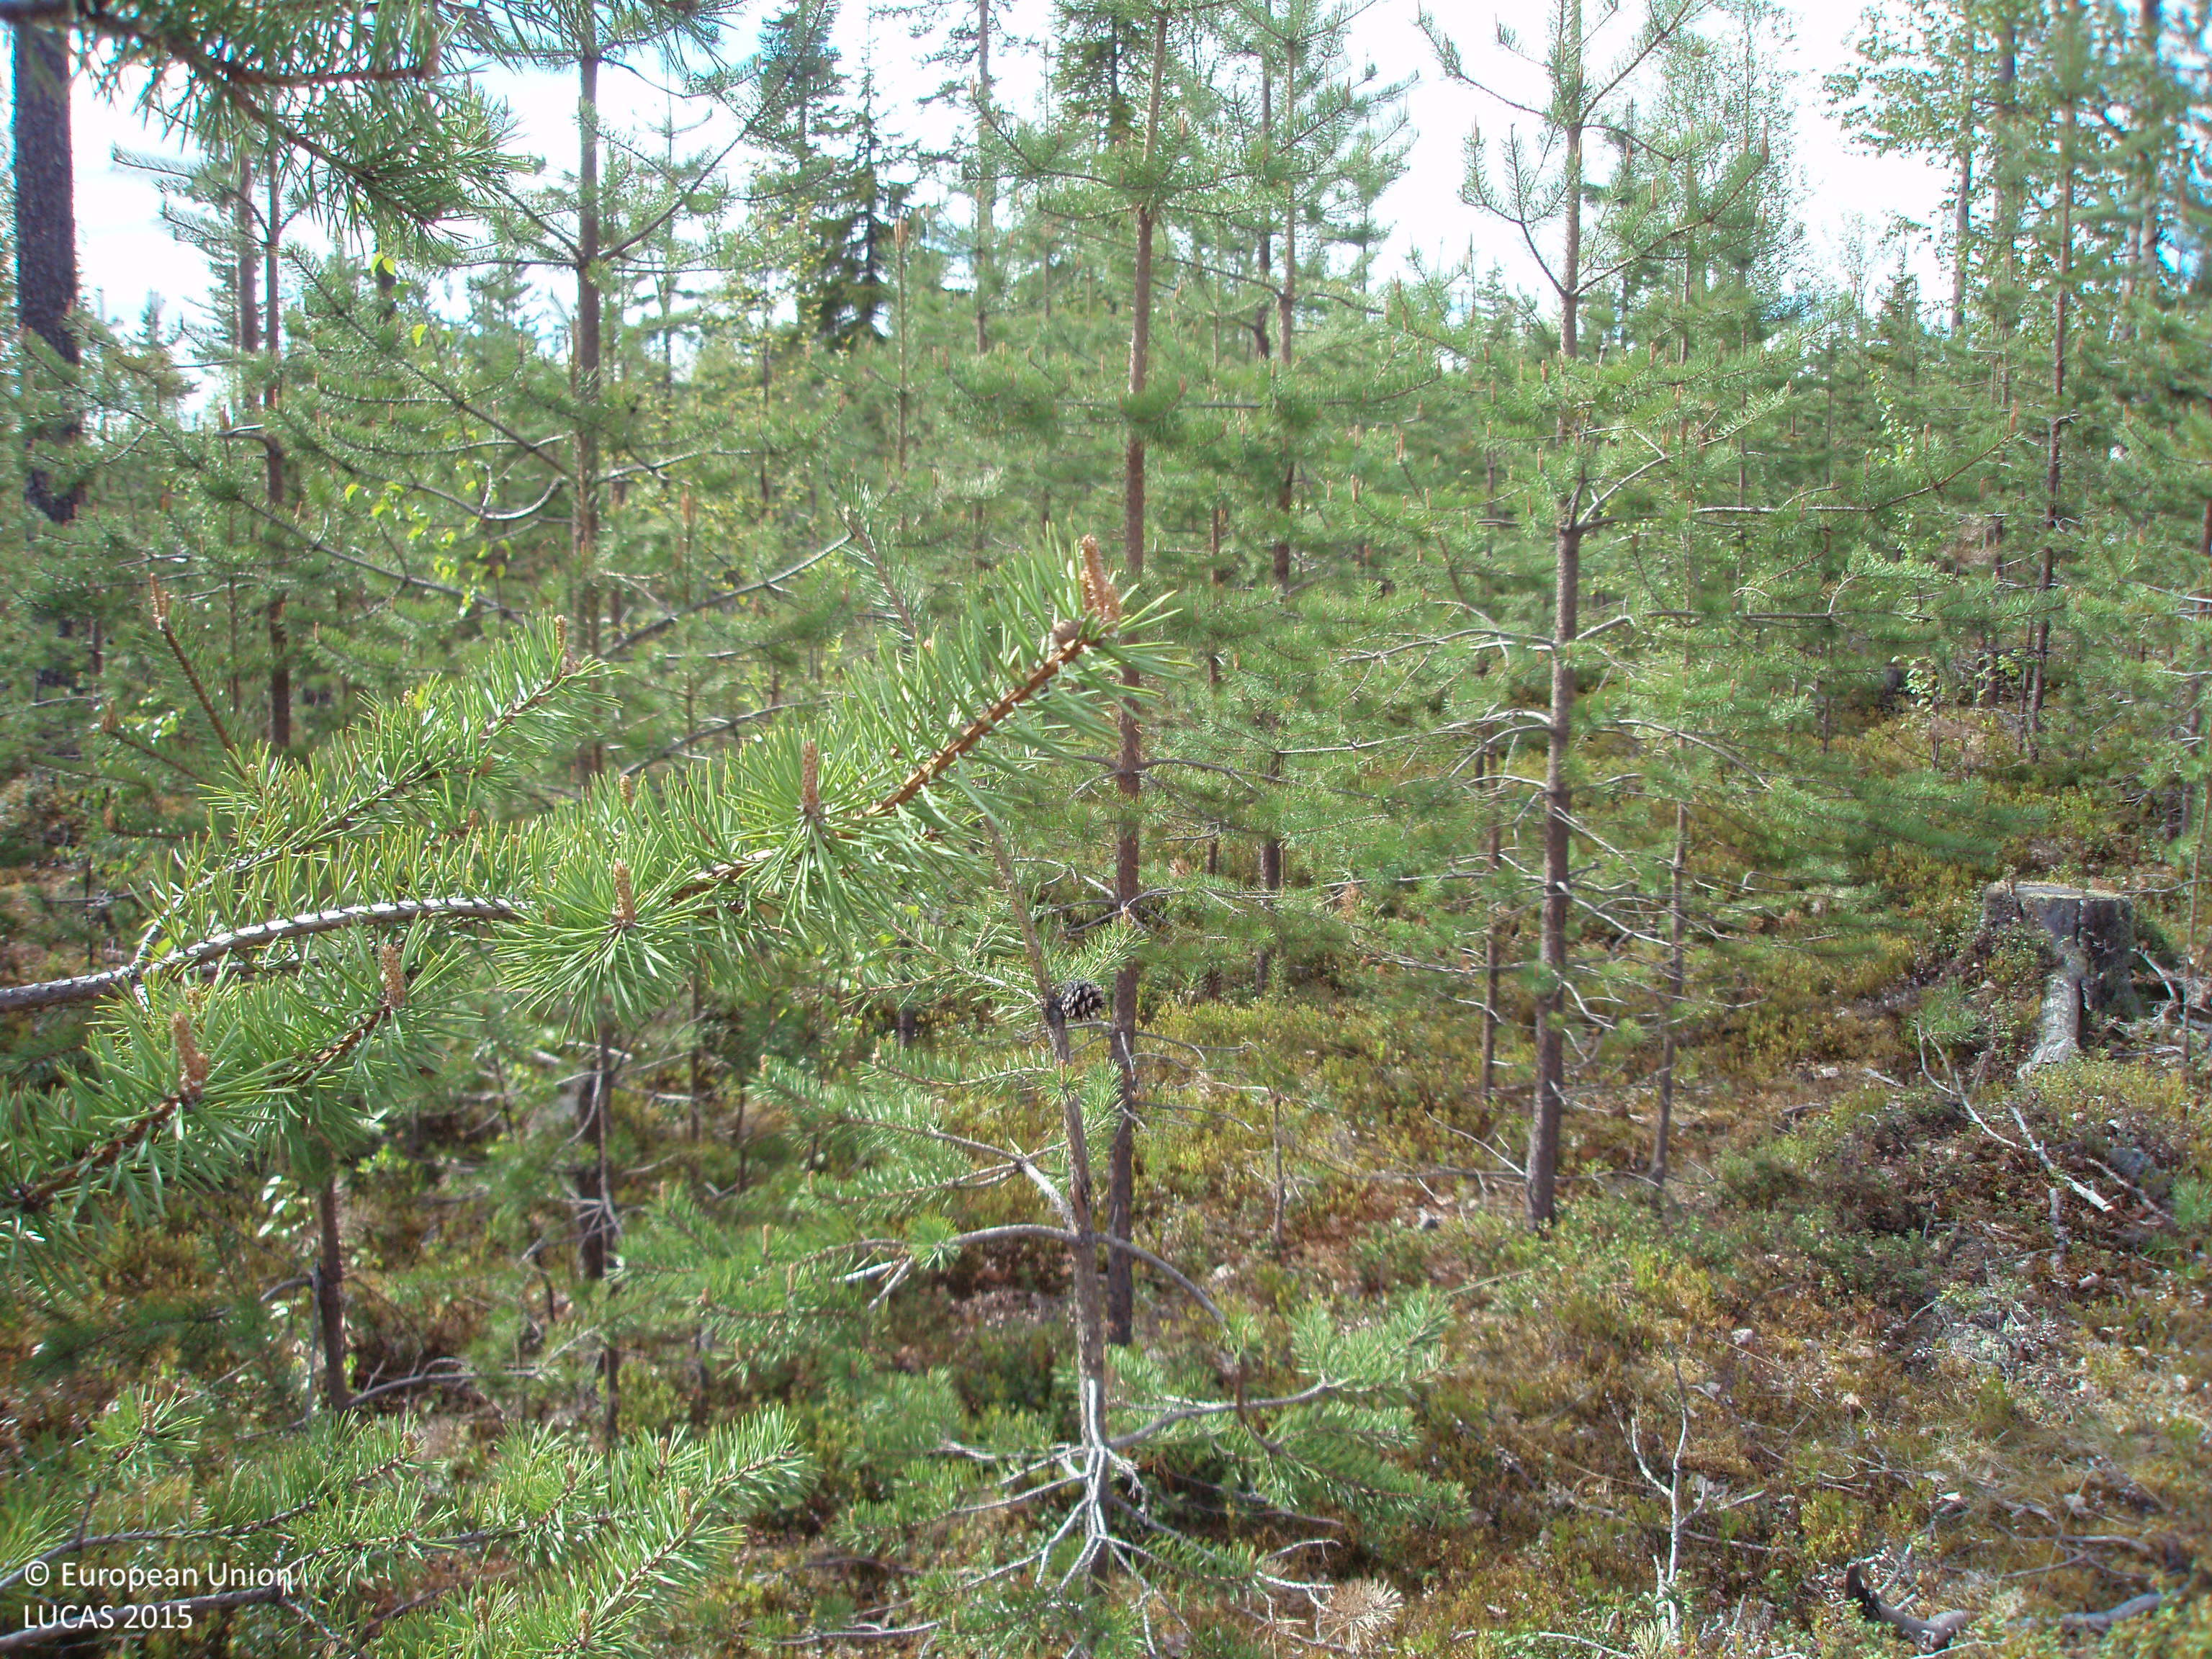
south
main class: Woodland
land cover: Pine dominated coniferous woodland
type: boreal forest
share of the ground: 50 - 75 %
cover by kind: coniferous forest trees 50 %, shrubs 45 %, broadleaved forest trees 5 %
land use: Forestry
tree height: > 5 m
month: June
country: FI
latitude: 66.8218
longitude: 27.5275
